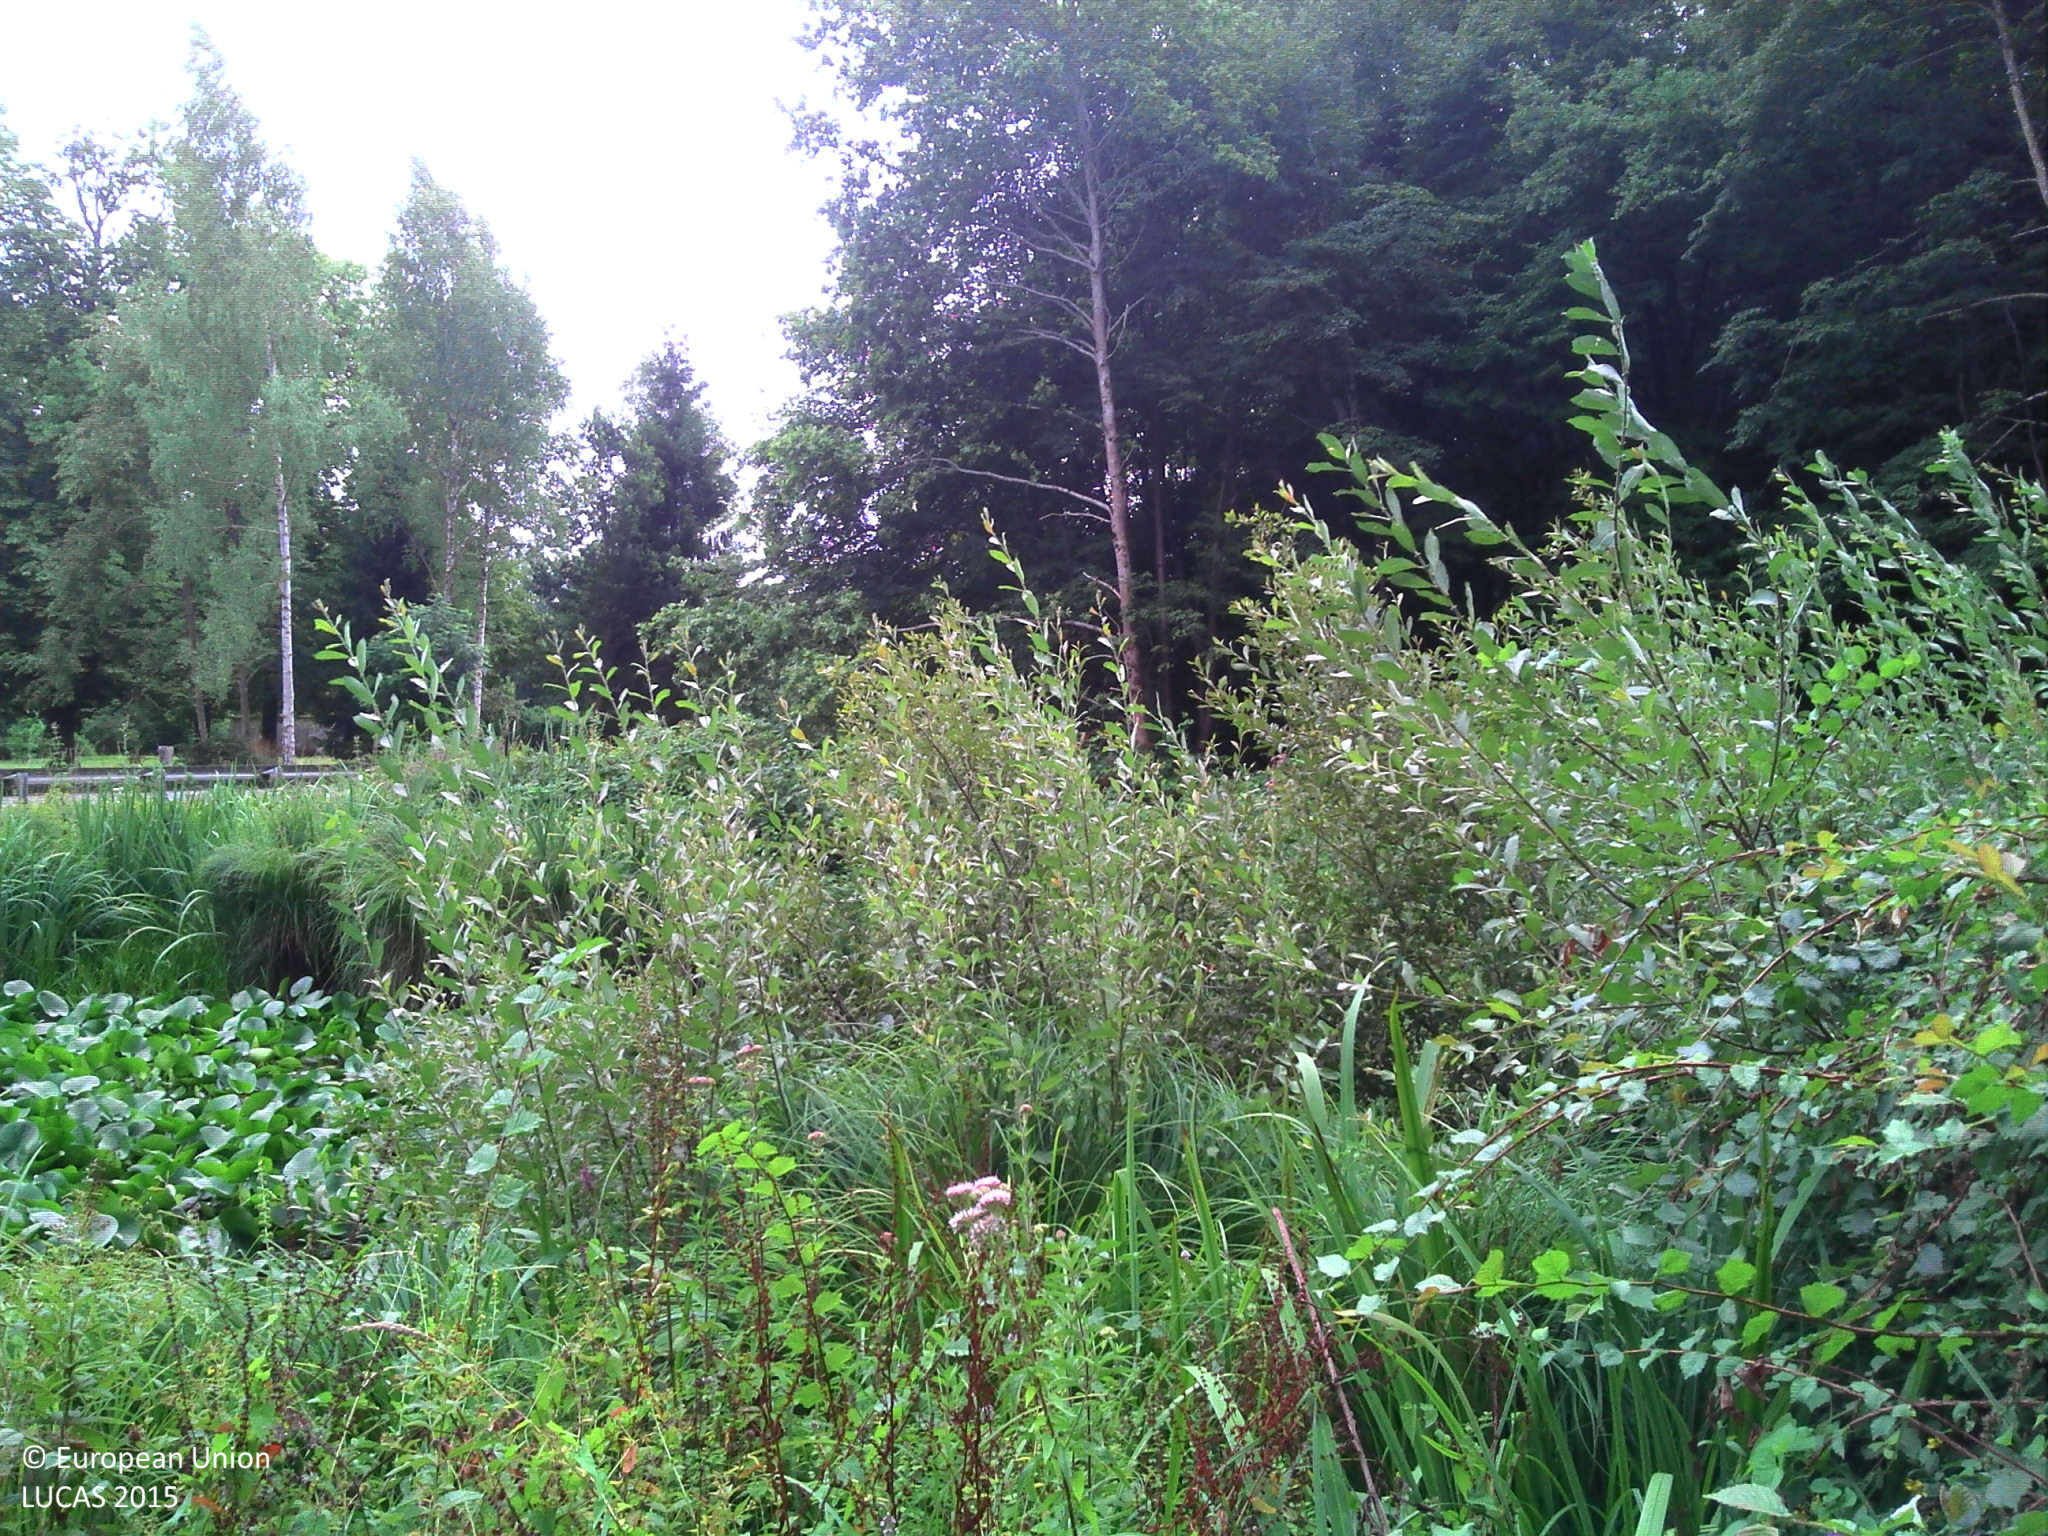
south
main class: Woodland
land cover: Broadleaved woodland
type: acidophilous oak and oak-birch forest
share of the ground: > 75 %
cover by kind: broadleaved forest trees 100 %
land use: Forestry
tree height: > 5 m
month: July
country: FR
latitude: 48.7214
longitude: 2.6905
